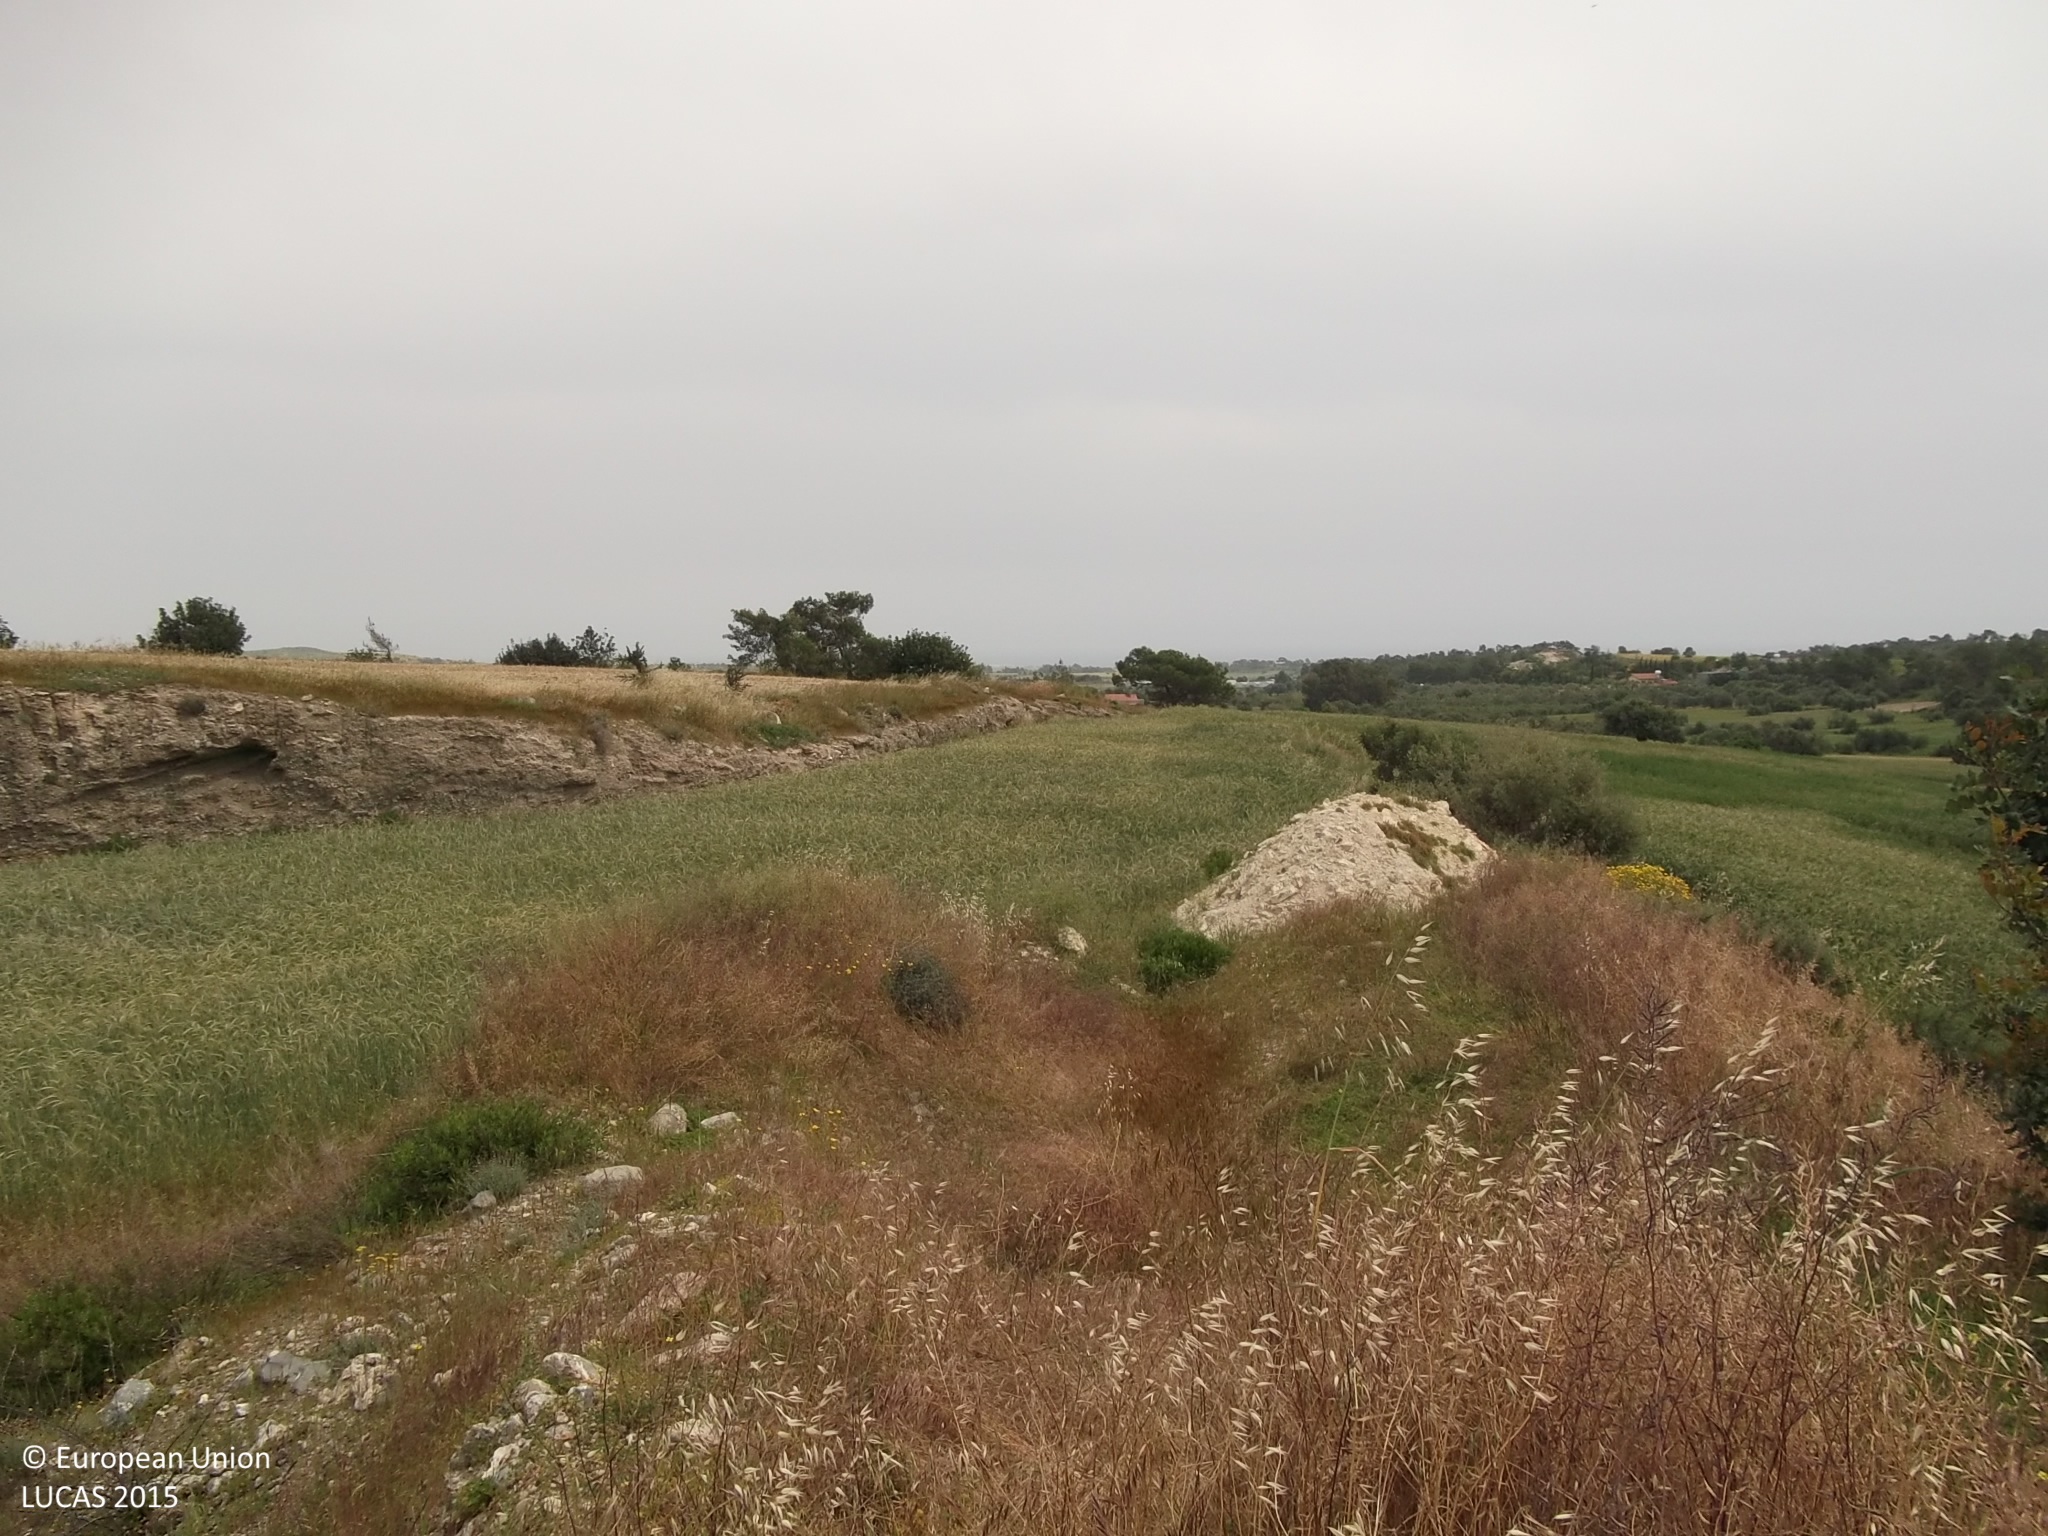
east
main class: Grassland
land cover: Spontaneously vegetated surfaces
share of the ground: > 75 %
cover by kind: herbaceous plants 85 %, unconsolidated bare surface 15 %
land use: Semi-natural and natural areas not in use
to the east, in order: Spontaneously vegetated surfaces; Rock outcrops; Common wheat; Single bushes/trees; Common wheat; Tracks; Rock outcrops; Grassland with sparse tree/shrub cover; Barley; Rock outcrops; Barley; Grass margins; Mixed cereals for fodder
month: April
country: CY
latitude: 34.8415
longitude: 33.4694
